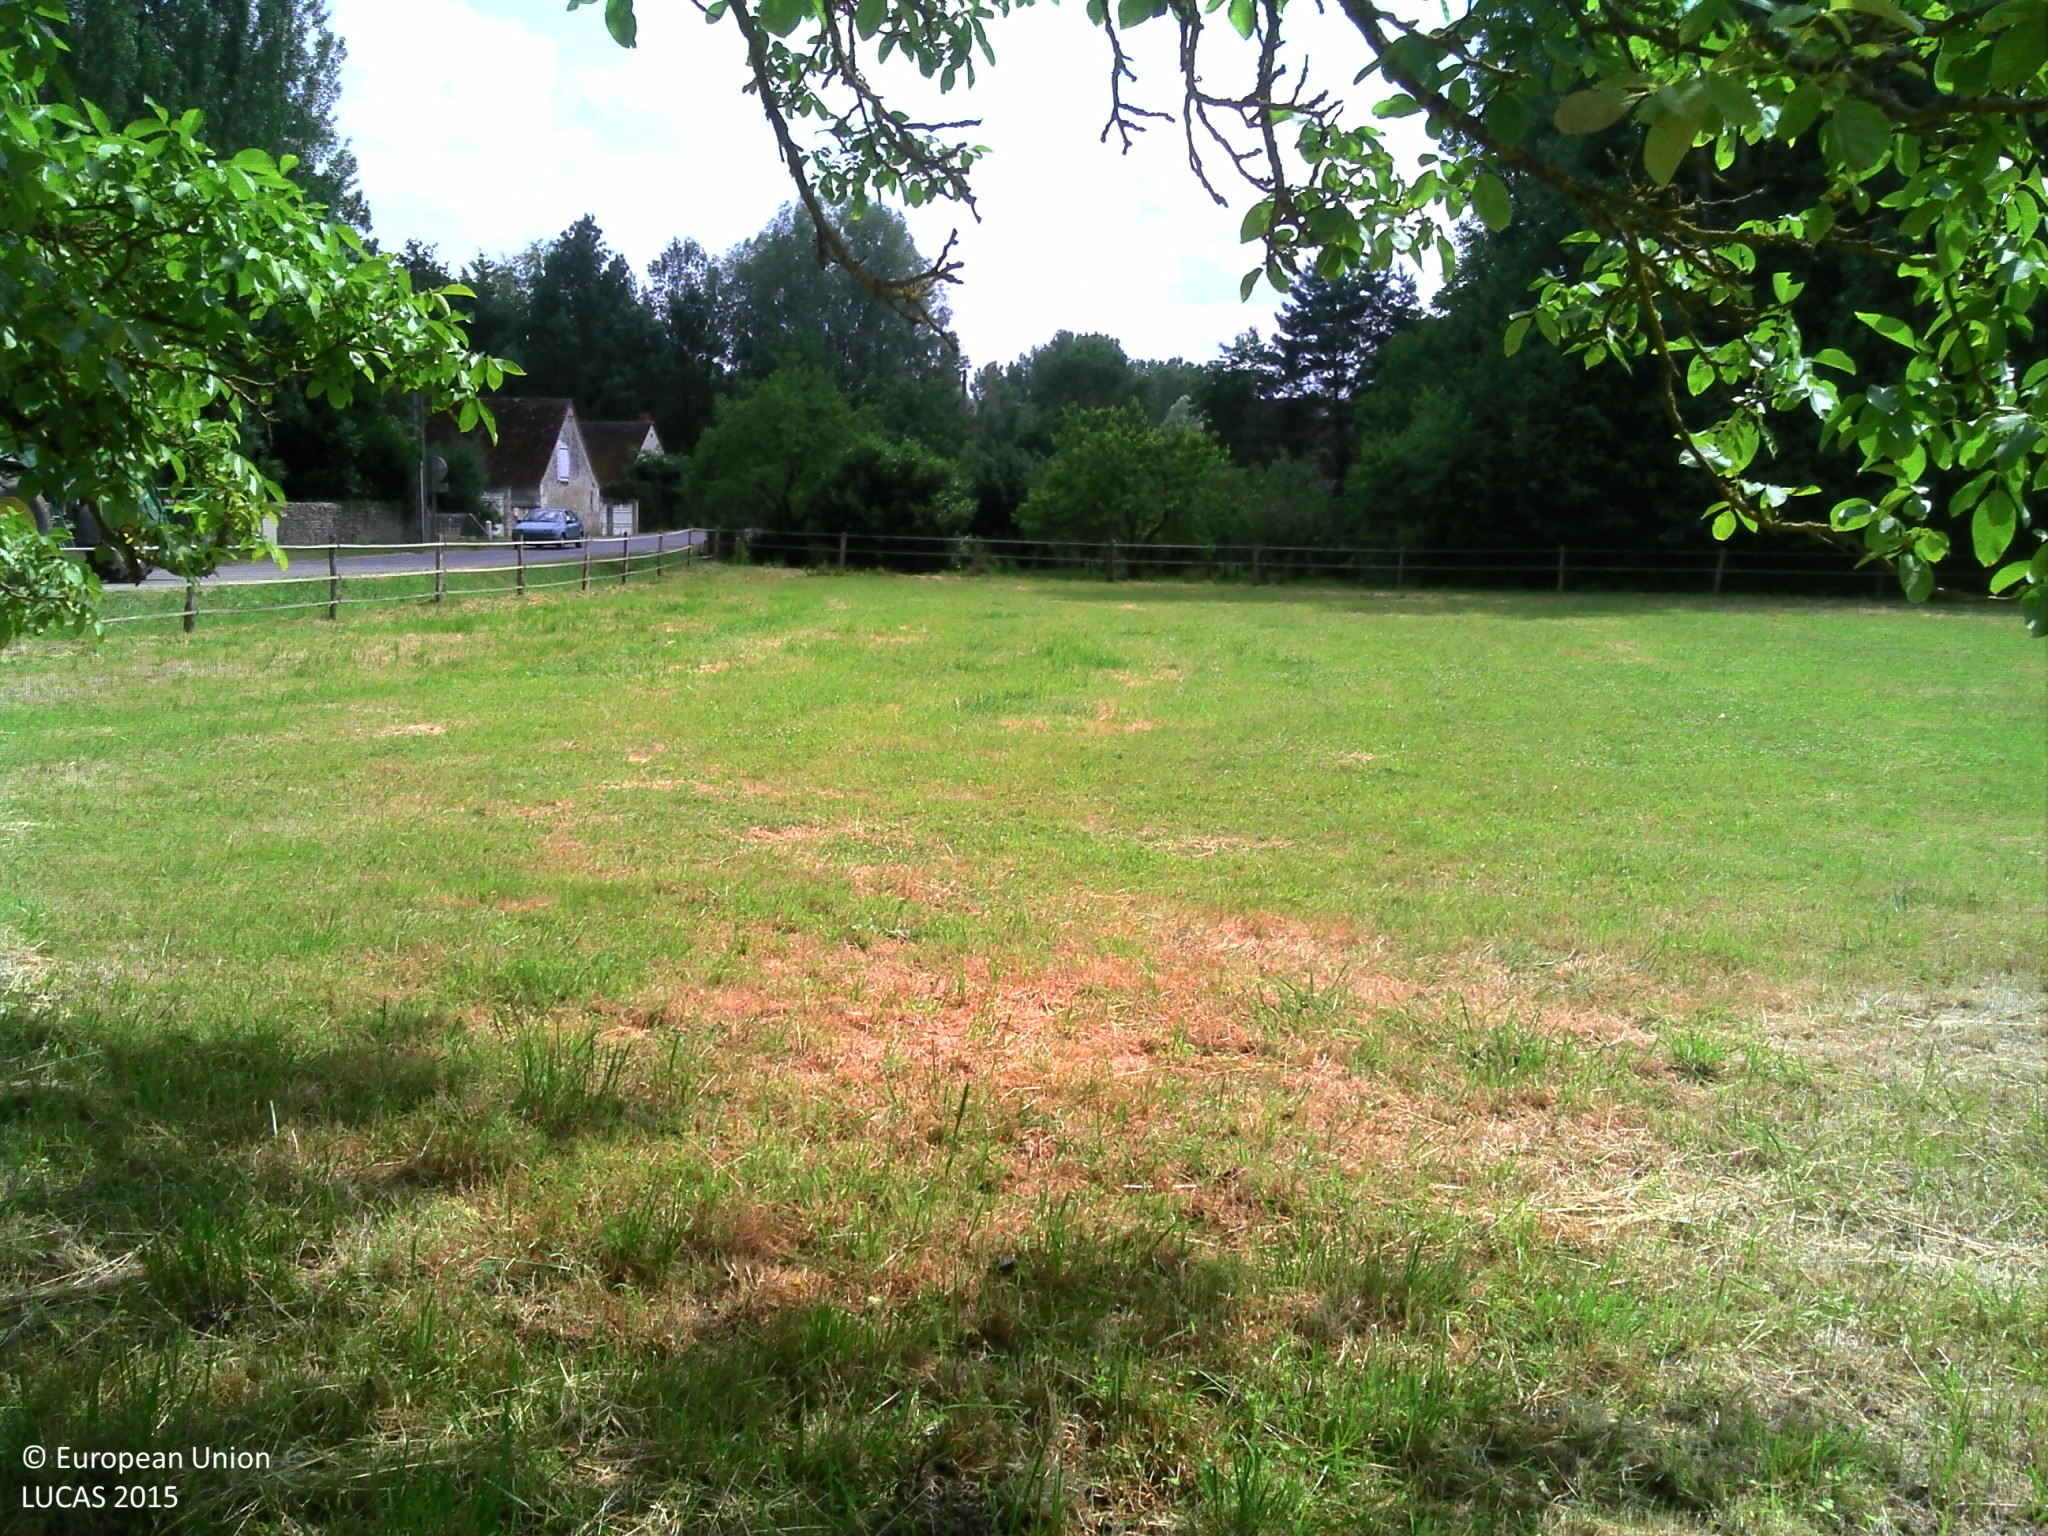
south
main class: Grassland
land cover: Grassland with sparse tree/shrub cover
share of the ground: > 75 %
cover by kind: herbaceous plants 95 %, broadleaved forest trees 5 %
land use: Residential
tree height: > 5 m
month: June
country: FR
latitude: 47.0818
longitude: 1.0677
